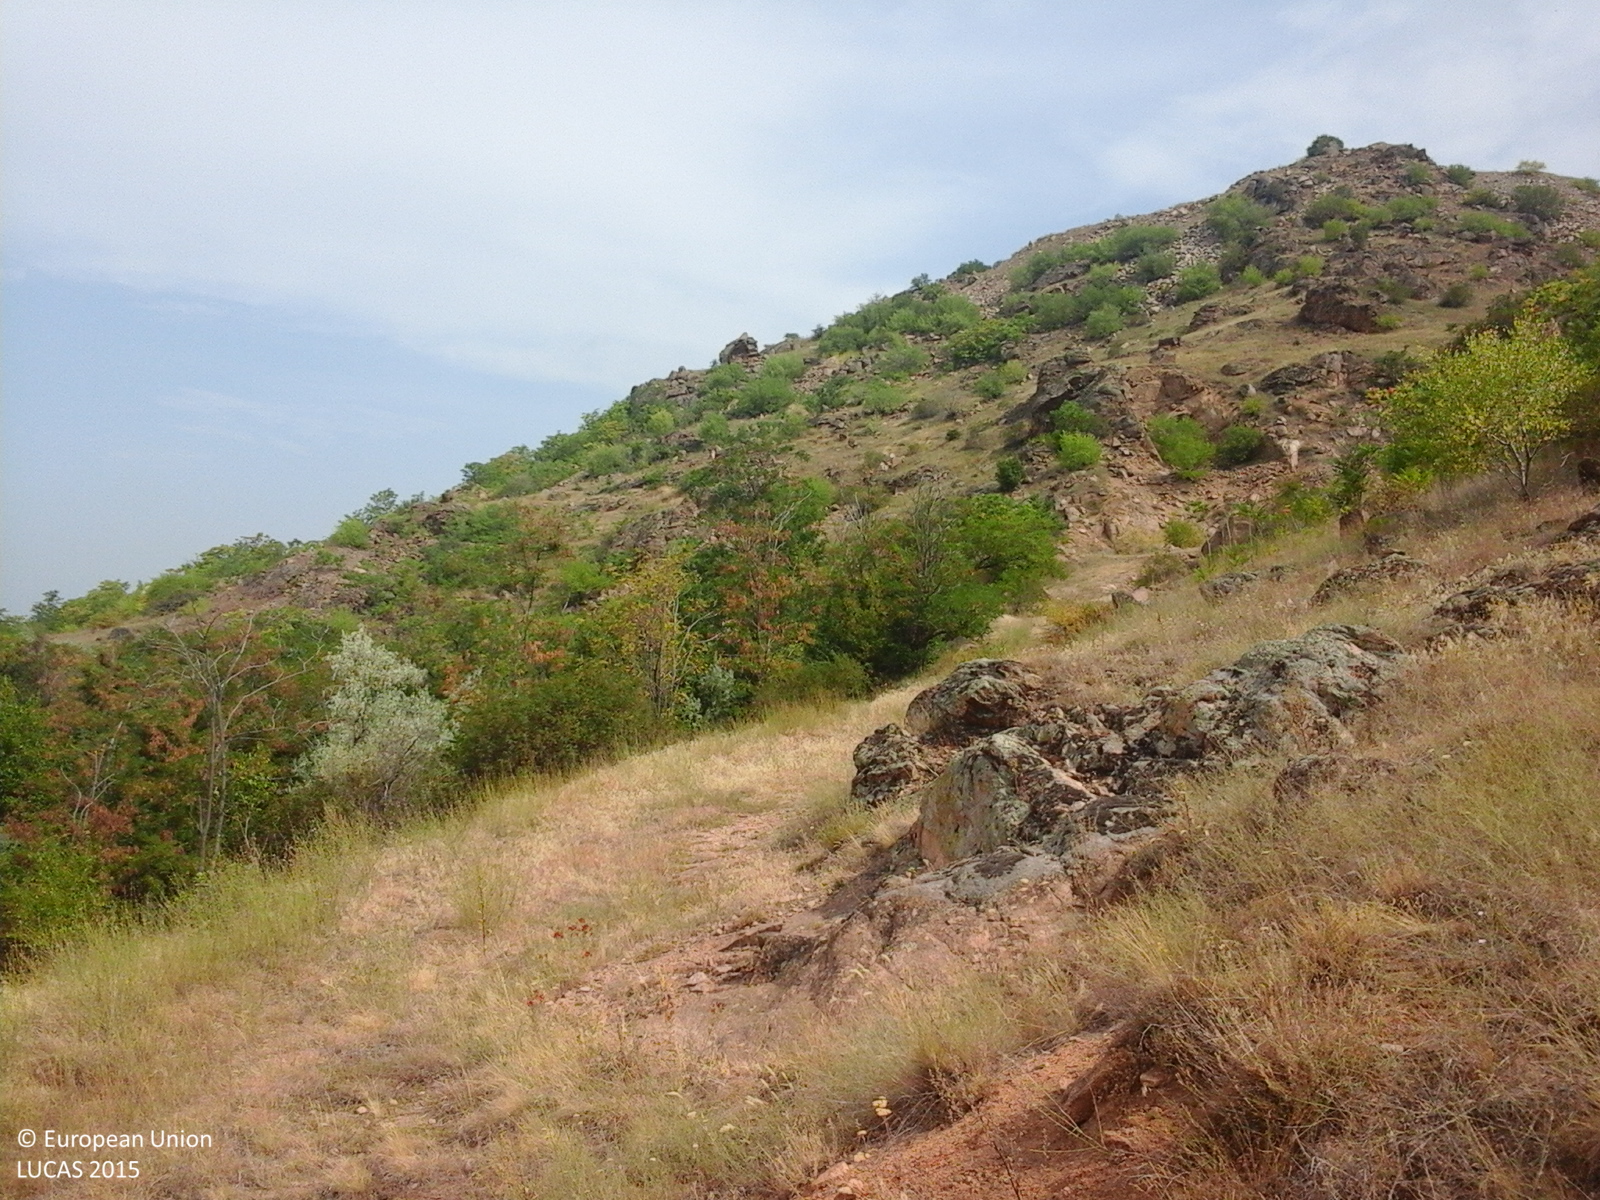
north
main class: Grassland
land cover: Grassland without tree/shrub cover
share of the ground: > 75 %
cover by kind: herbaceous plants 100 %
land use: Agriculture (excluding fallow land and kitchen gardens)
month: July
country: RO
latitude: 45.2344
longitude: 28.1964
